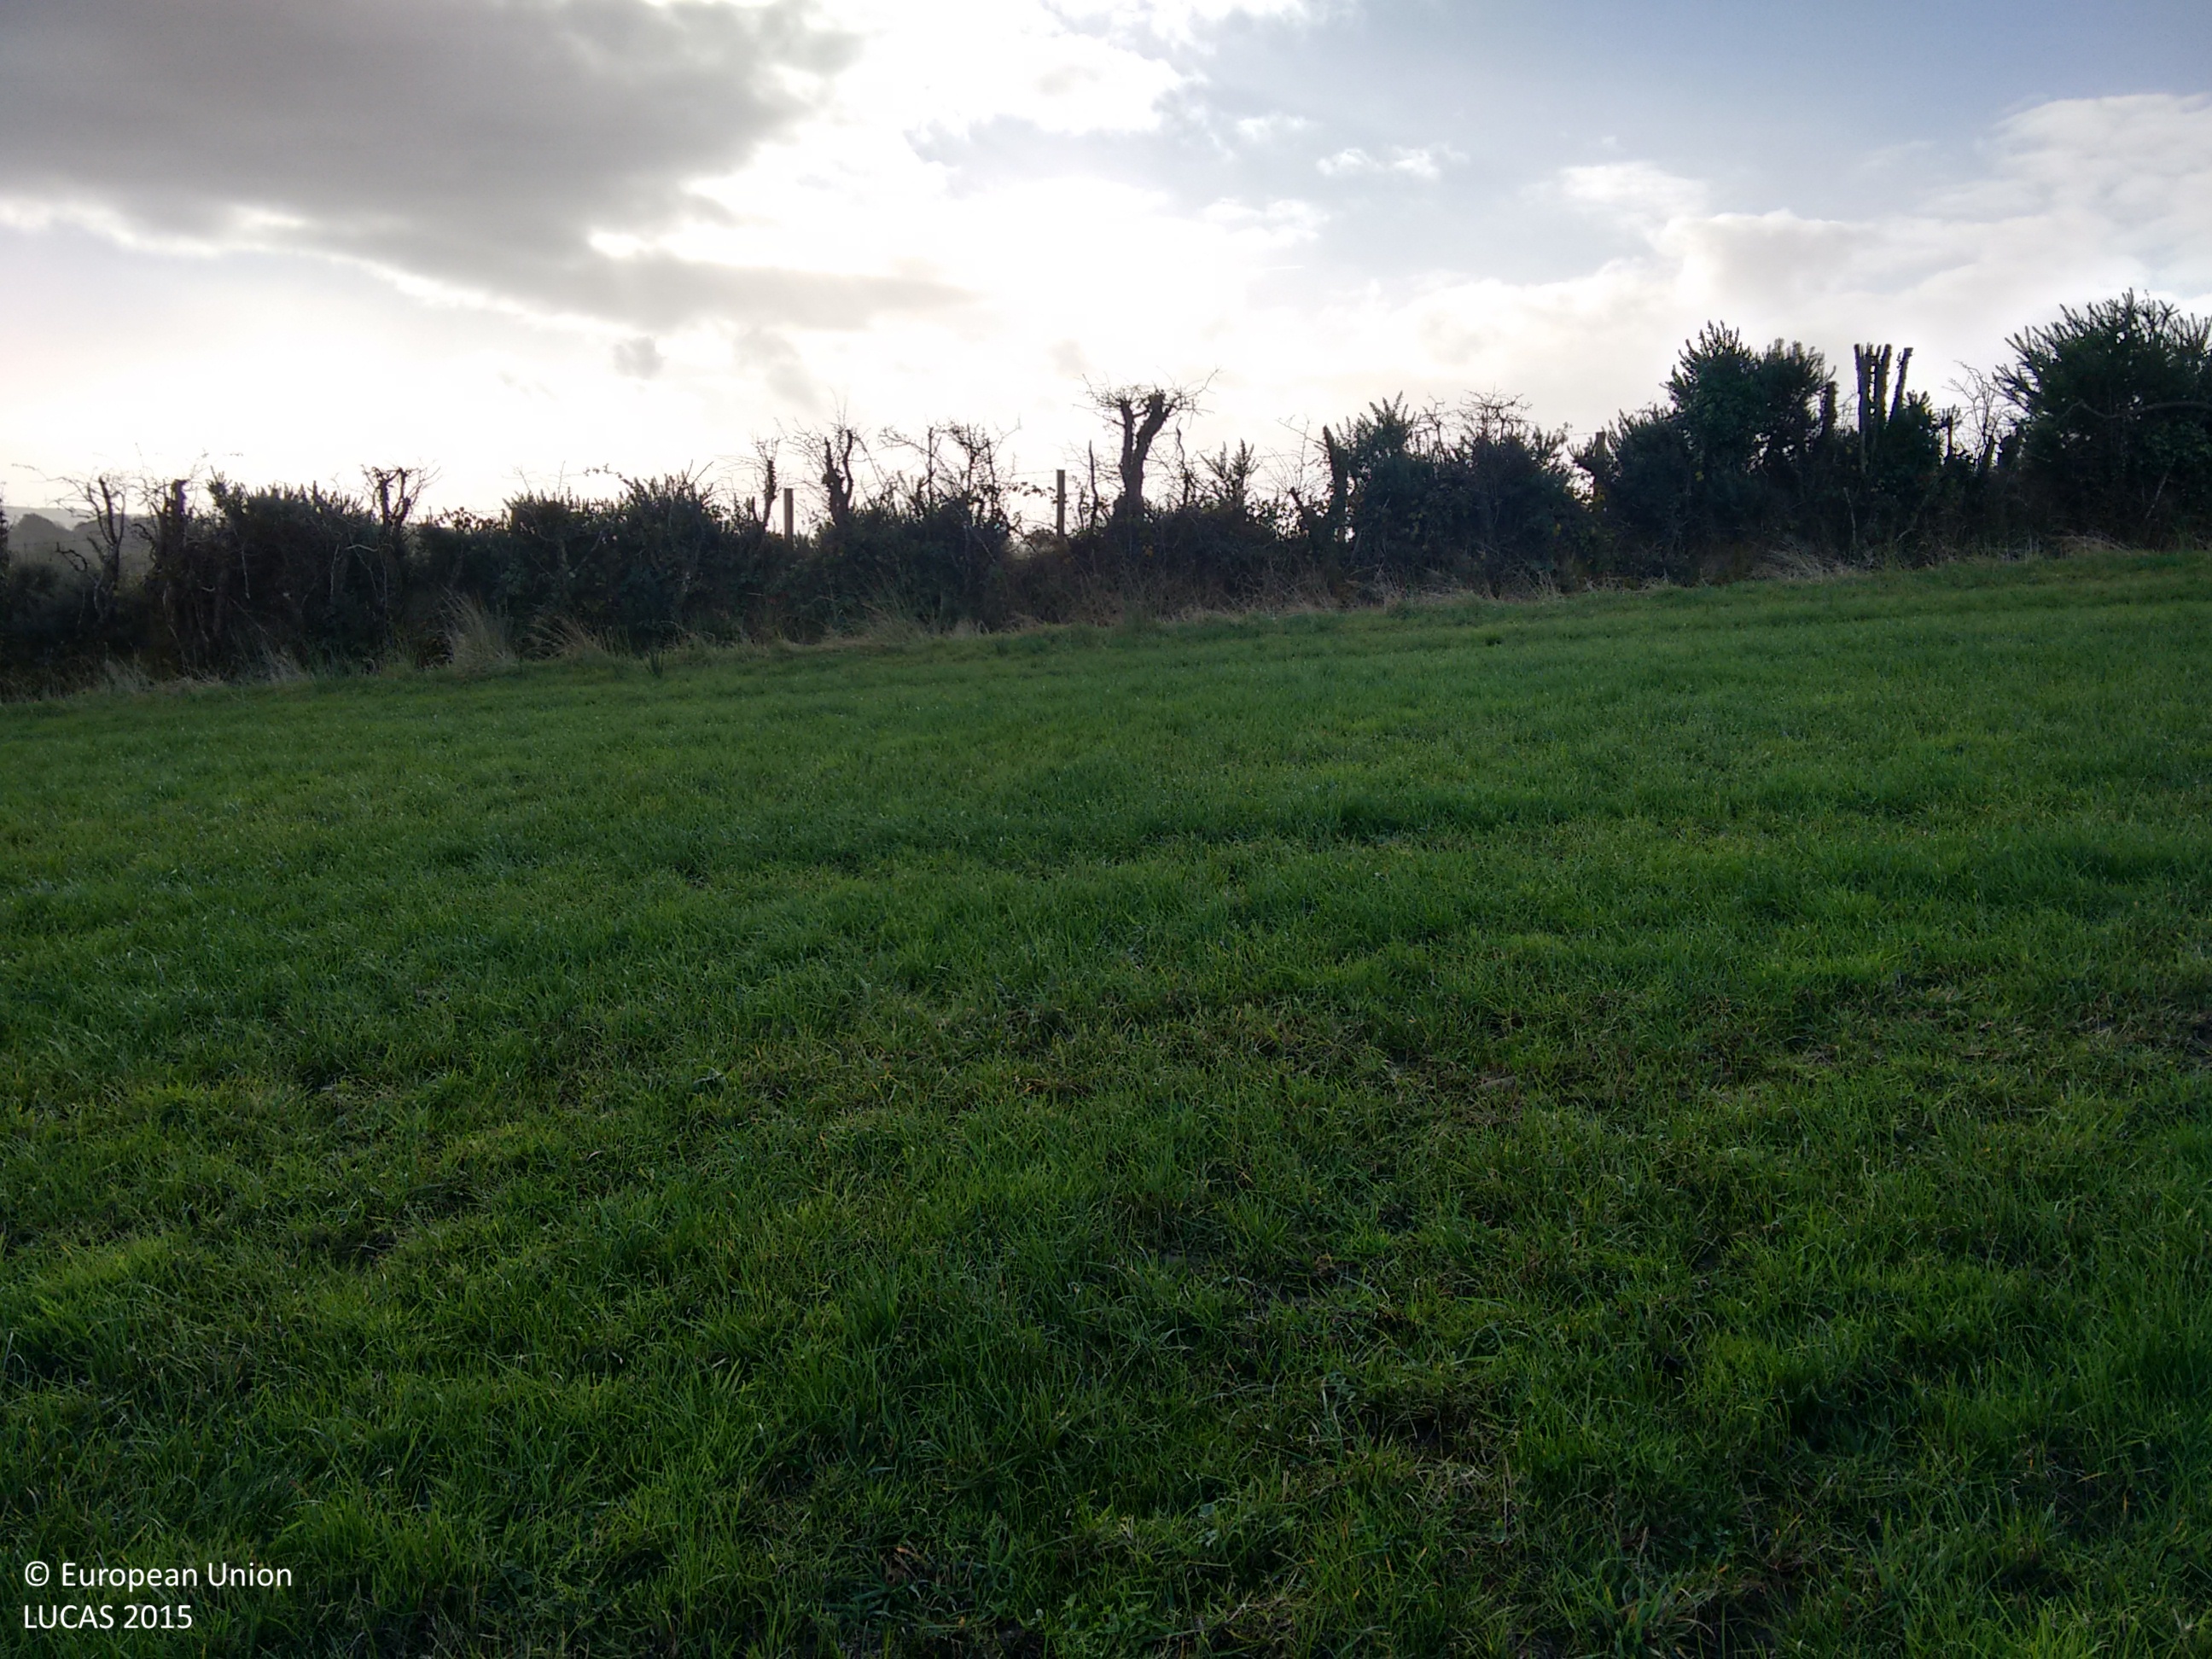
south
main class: Grassland
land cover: Grassland without tree/shrub cover
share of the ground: > 75 %
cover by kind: herbaceous plants 100 %
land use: Agriculture (excluding fallow land and kitchen gardens)
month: October
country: GB
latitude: 54.4830
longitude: -7.4251
